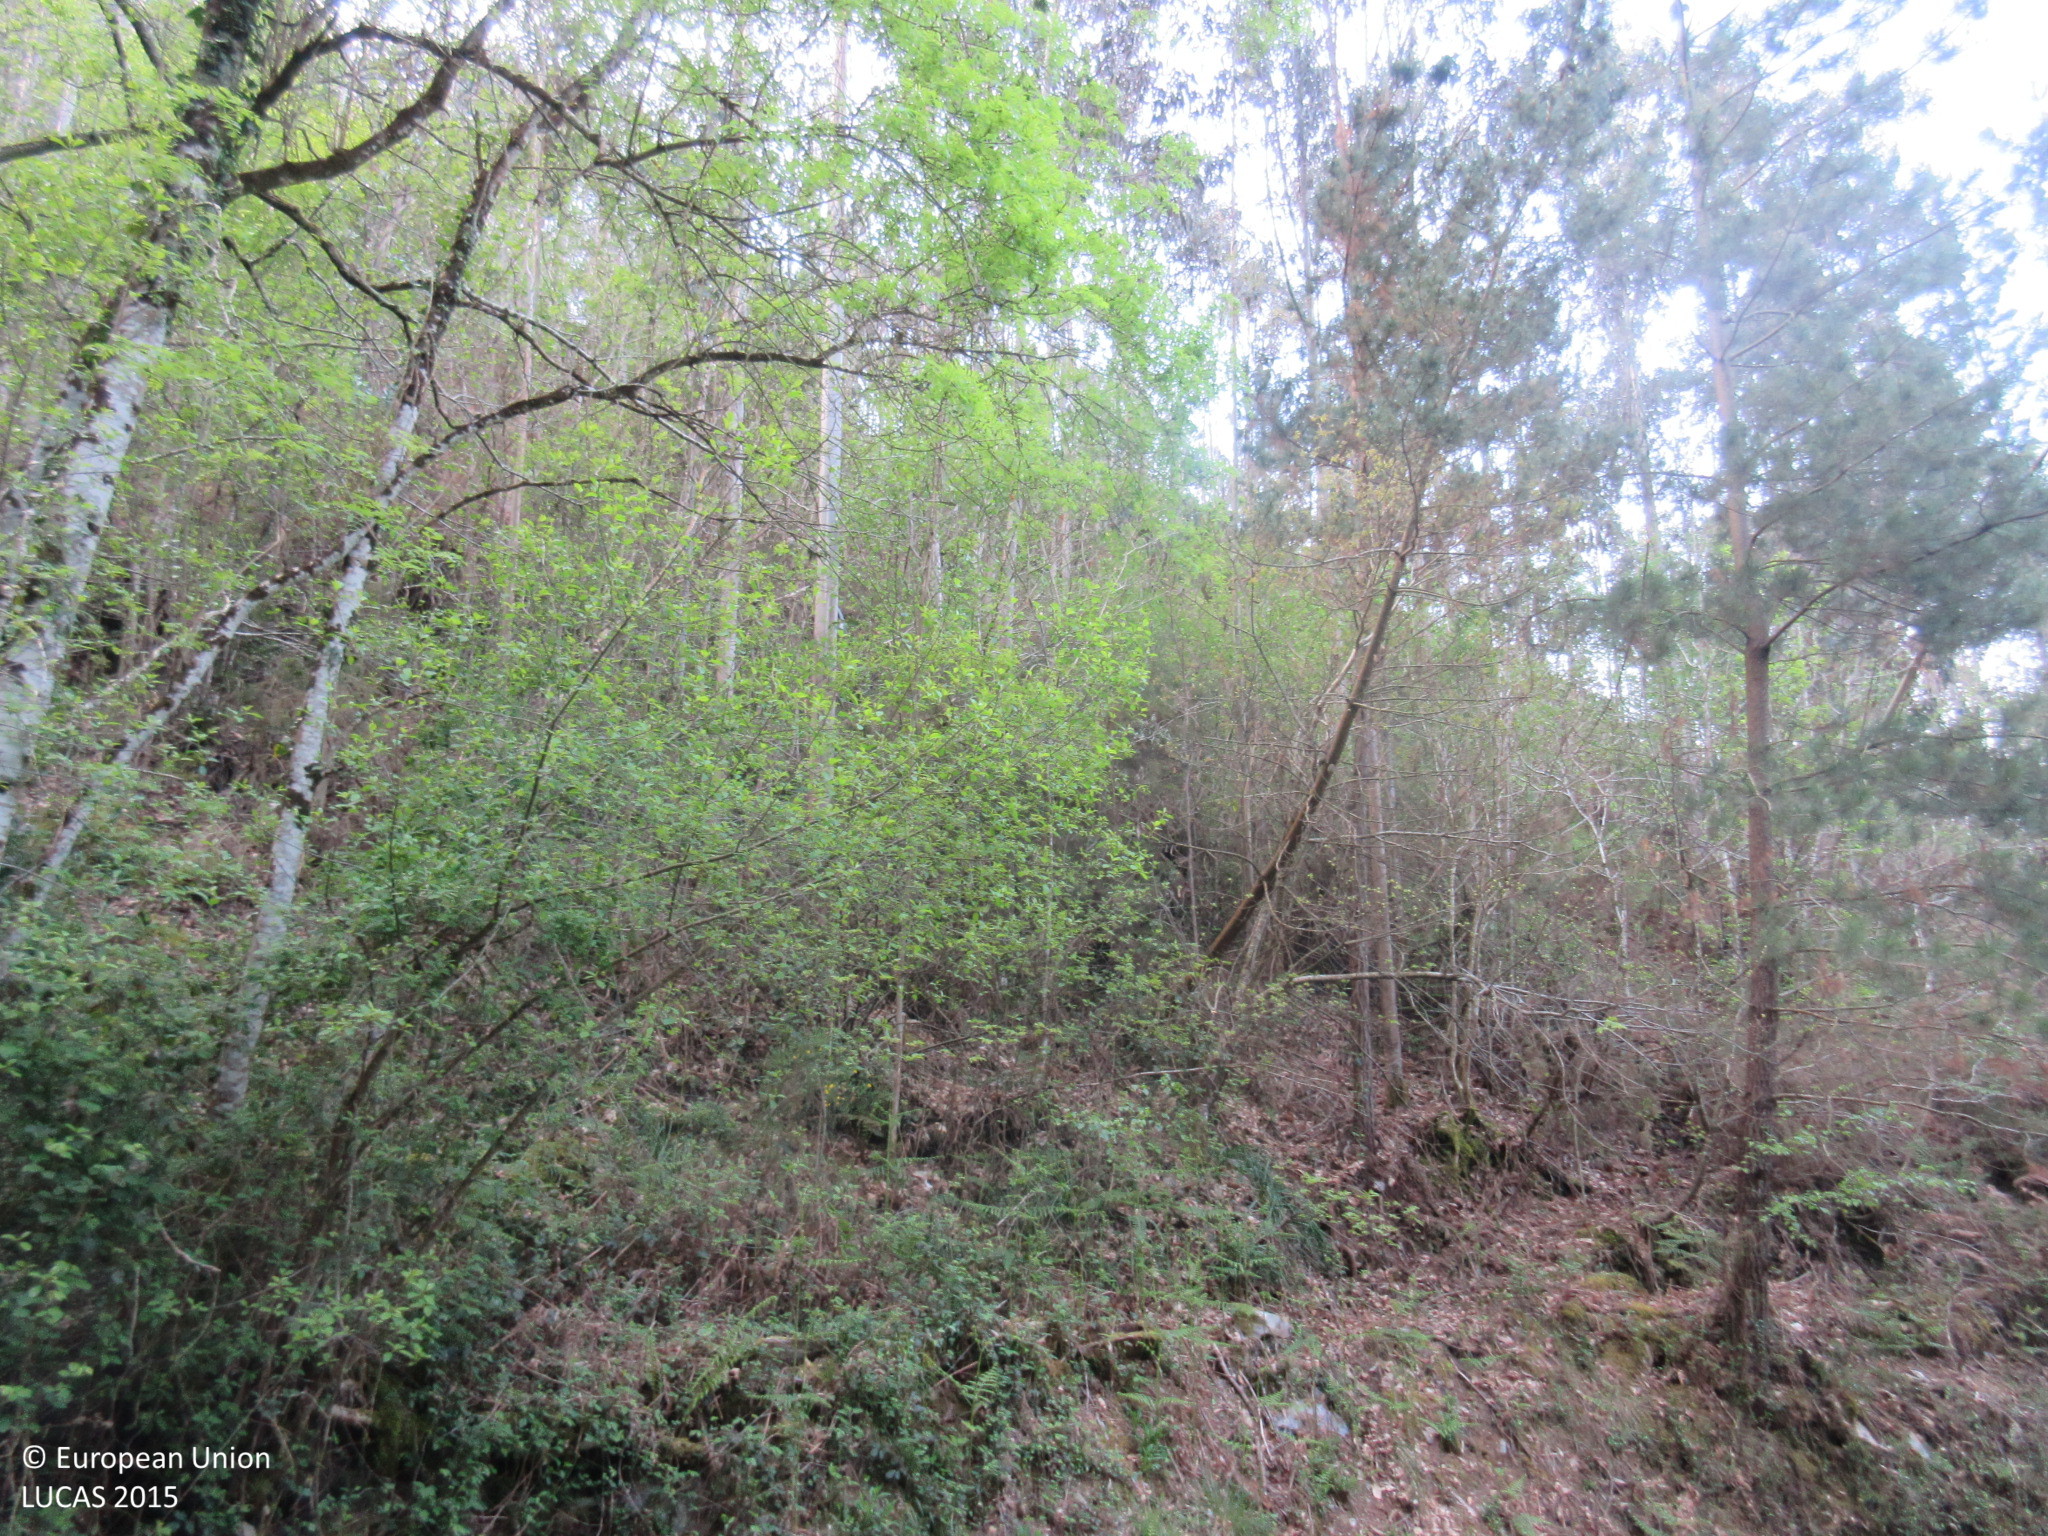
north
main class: Woodland
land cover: Broadleaved woodland
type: exotic forest
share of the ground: > 75 %
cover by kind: broadleaved forest trees 90 %, shrubs 10 %
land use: Forestry
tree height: > 5 m
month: April
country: ES
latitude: 43.4139
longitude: -6.9987
